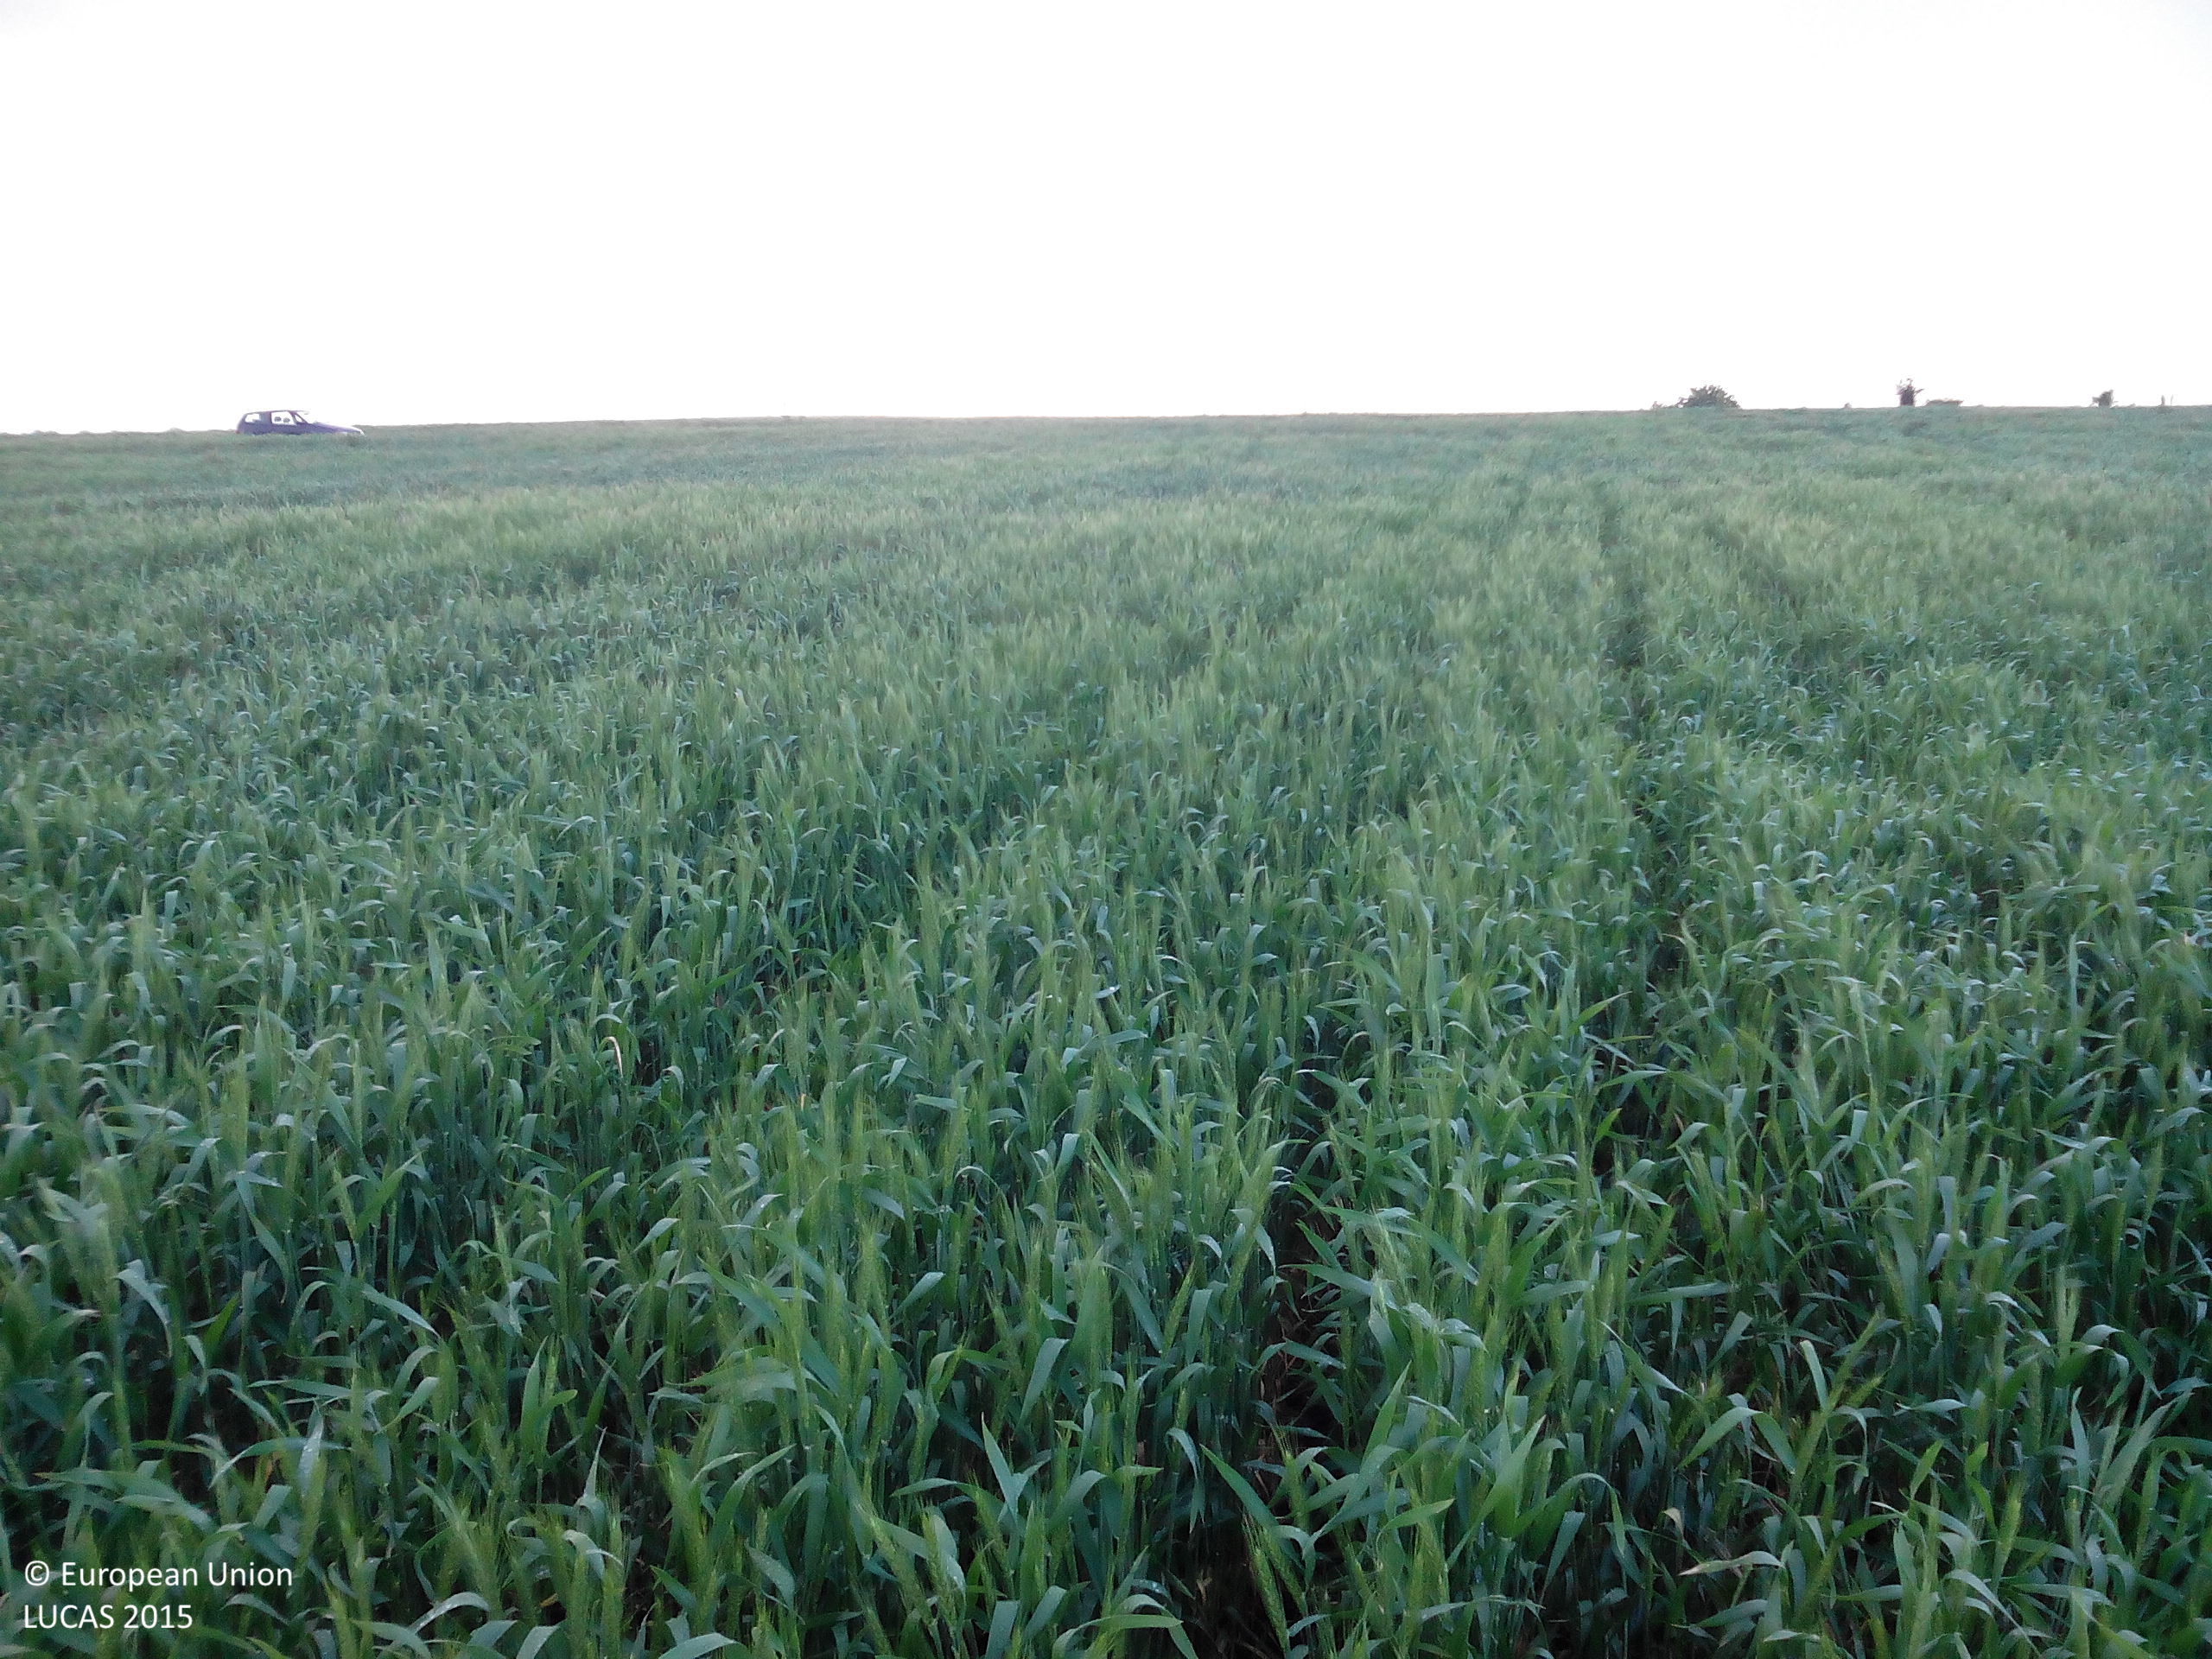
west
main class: Cropland
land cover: Barley
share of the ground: > 75 %
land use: Agriculture (excluding fallow land and kitchen gardens)
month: May
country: BG
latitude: 43.5124
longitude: 23.8177
